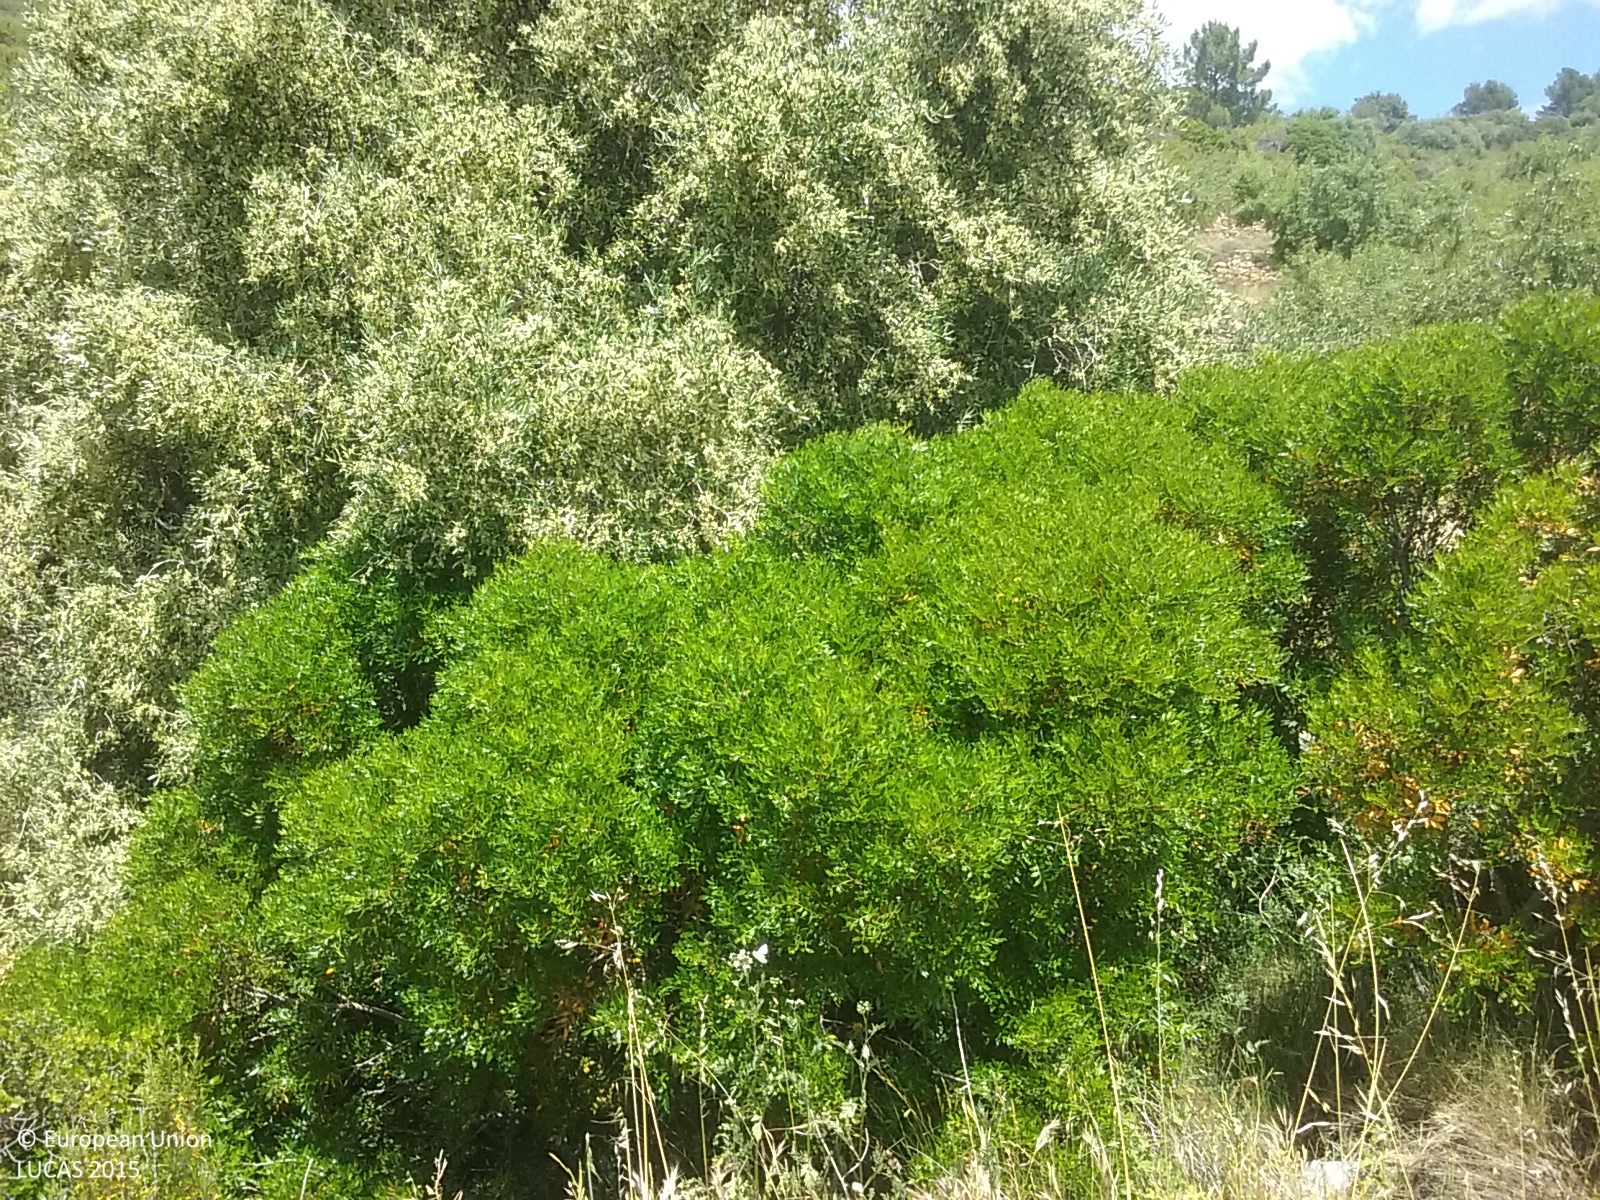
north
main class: Shrubland
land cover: Shrubland without tree cover
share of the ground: > 75 %
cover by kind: shrubs 95 %, herbaceous plants 5 %
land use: Semi-natural and natural areas not in use
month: May
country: ES
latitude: 40.3836
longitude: 0.0893
